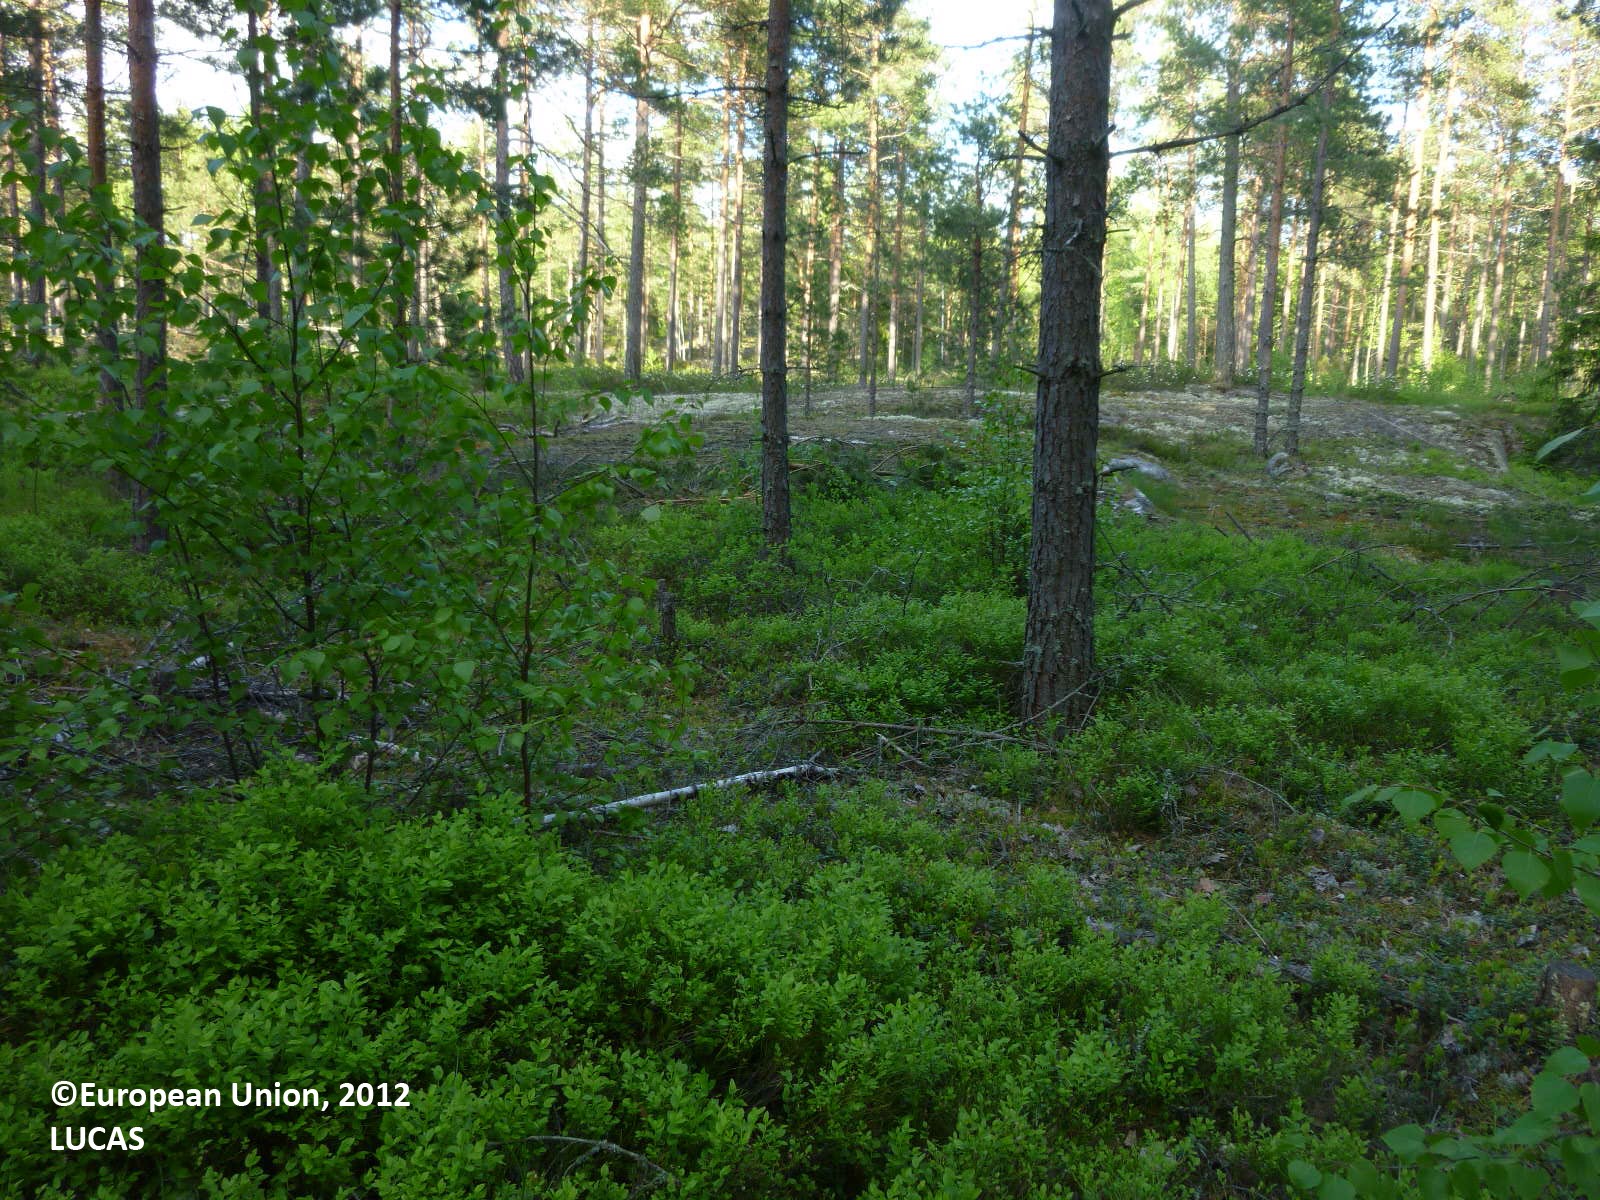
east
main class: Woodland
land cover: Pine dominated mixed woodland
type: boreal forest
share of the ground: 25 - 50 %
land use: Forestry
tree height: > 5 m
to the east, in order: Pine dominated mixed woodland; Pine dominated coniferous woodland; Rocks and stones; Pine dominated coniferous woodland
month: June
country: FI
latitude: 60.3441
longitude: 22.5926
